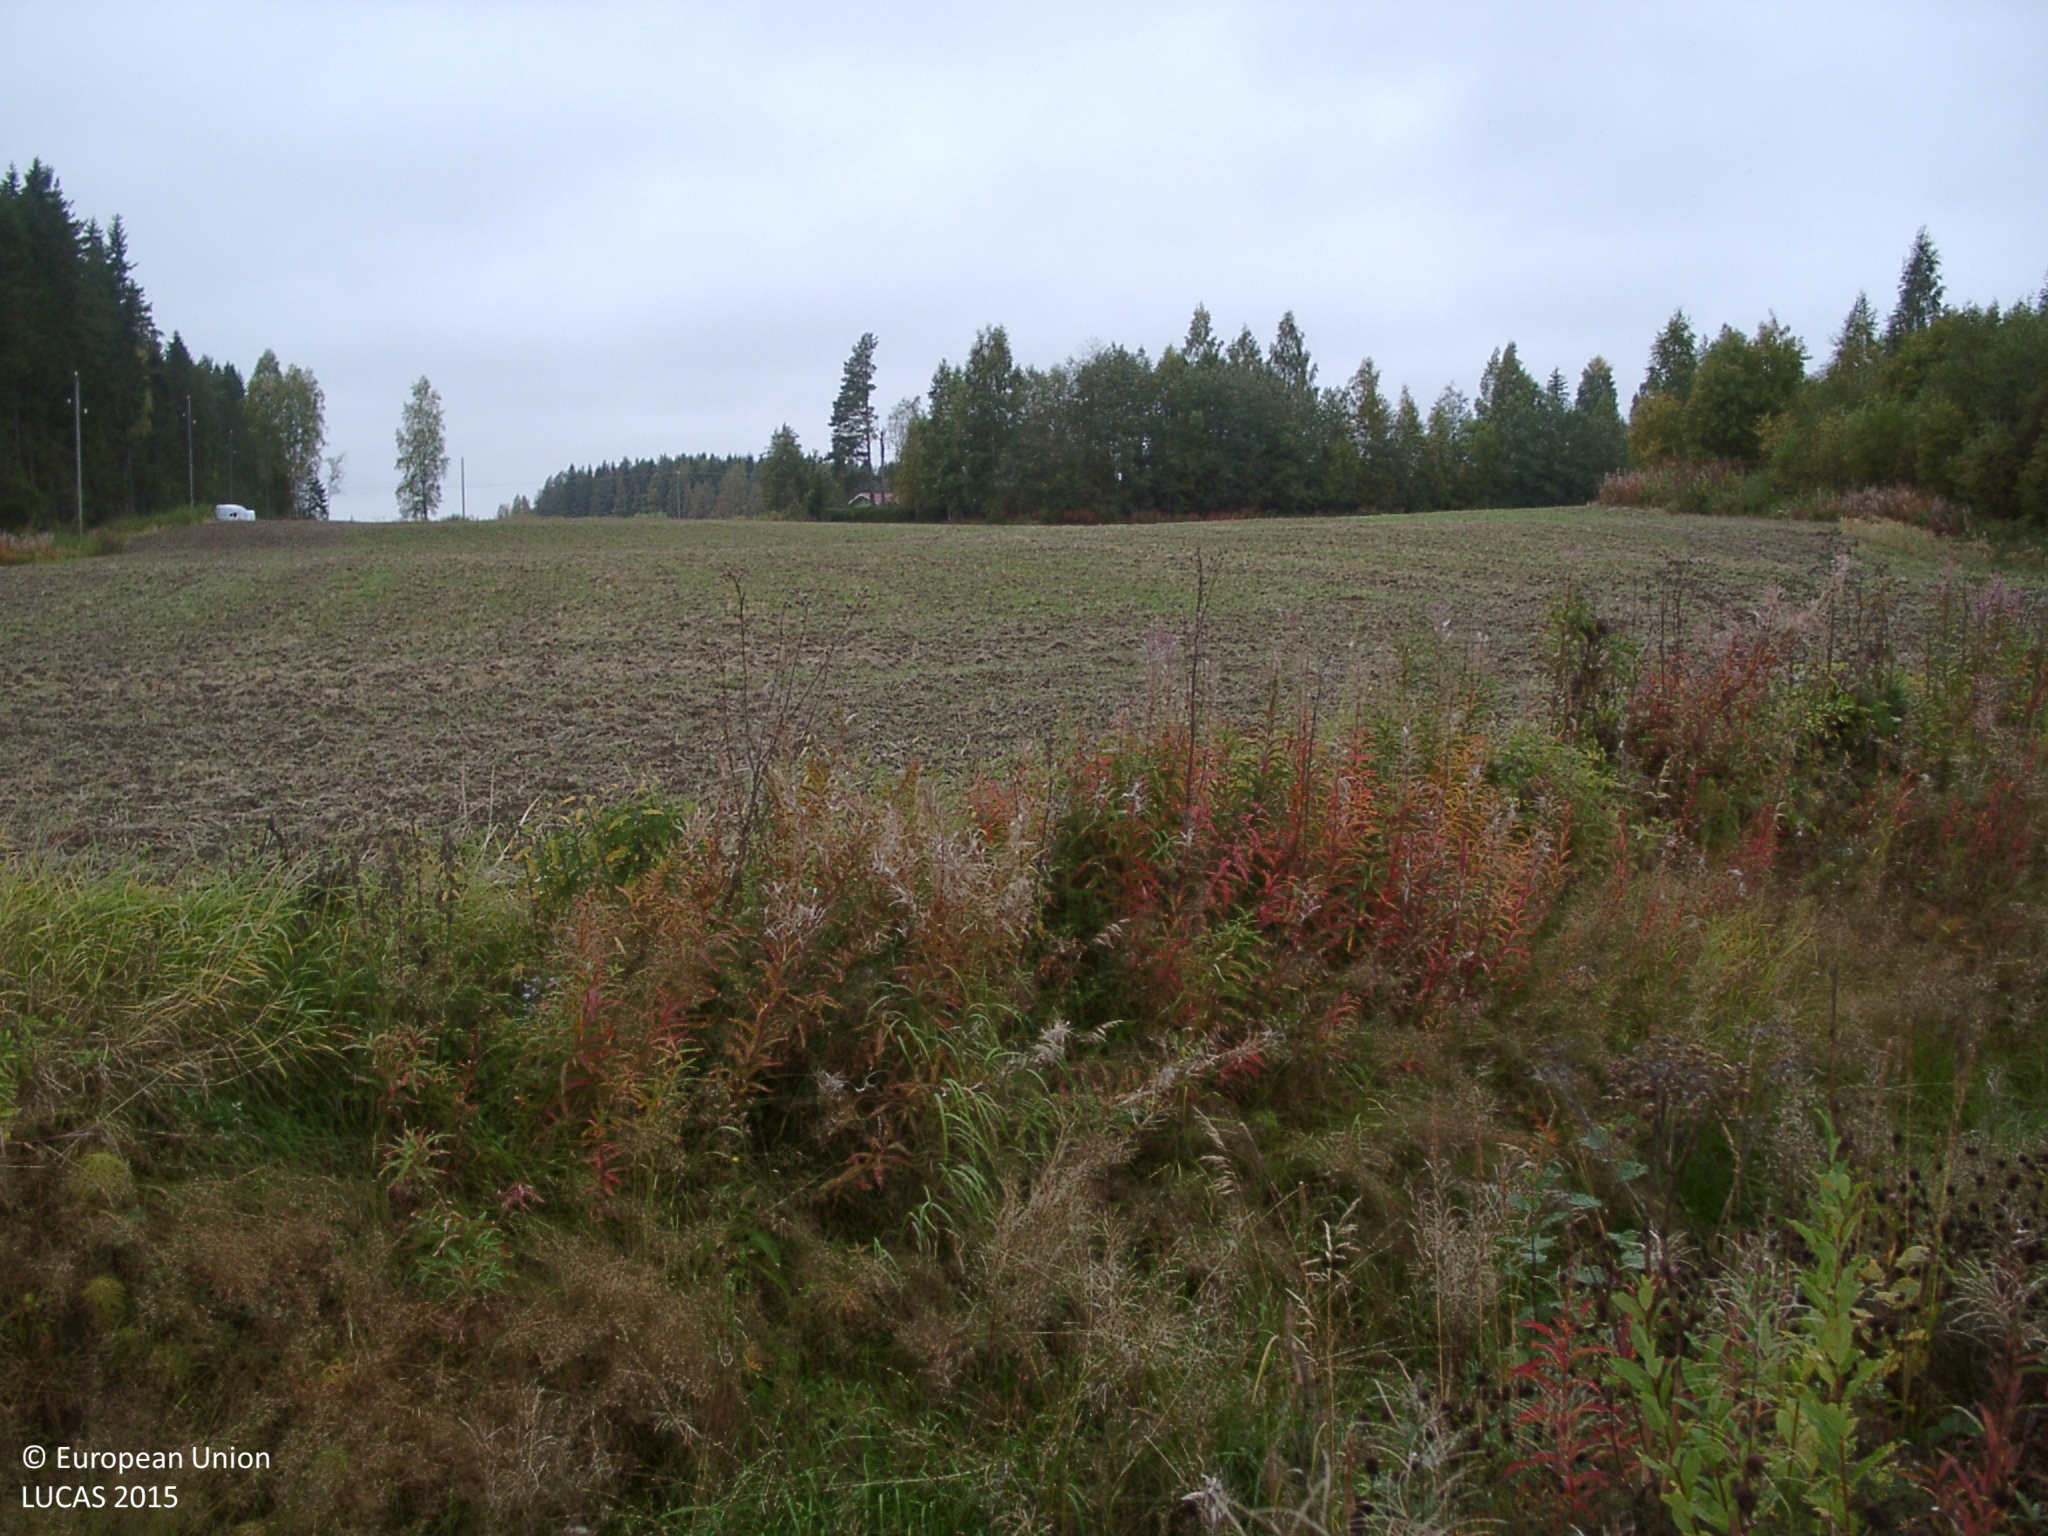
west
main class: Cropland
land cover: Barley
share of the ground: > 75 %
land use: Agriculture (excluding fallow land and kitchen gardens)
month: September
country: FI
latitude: 62.7531
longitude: 25.7588
